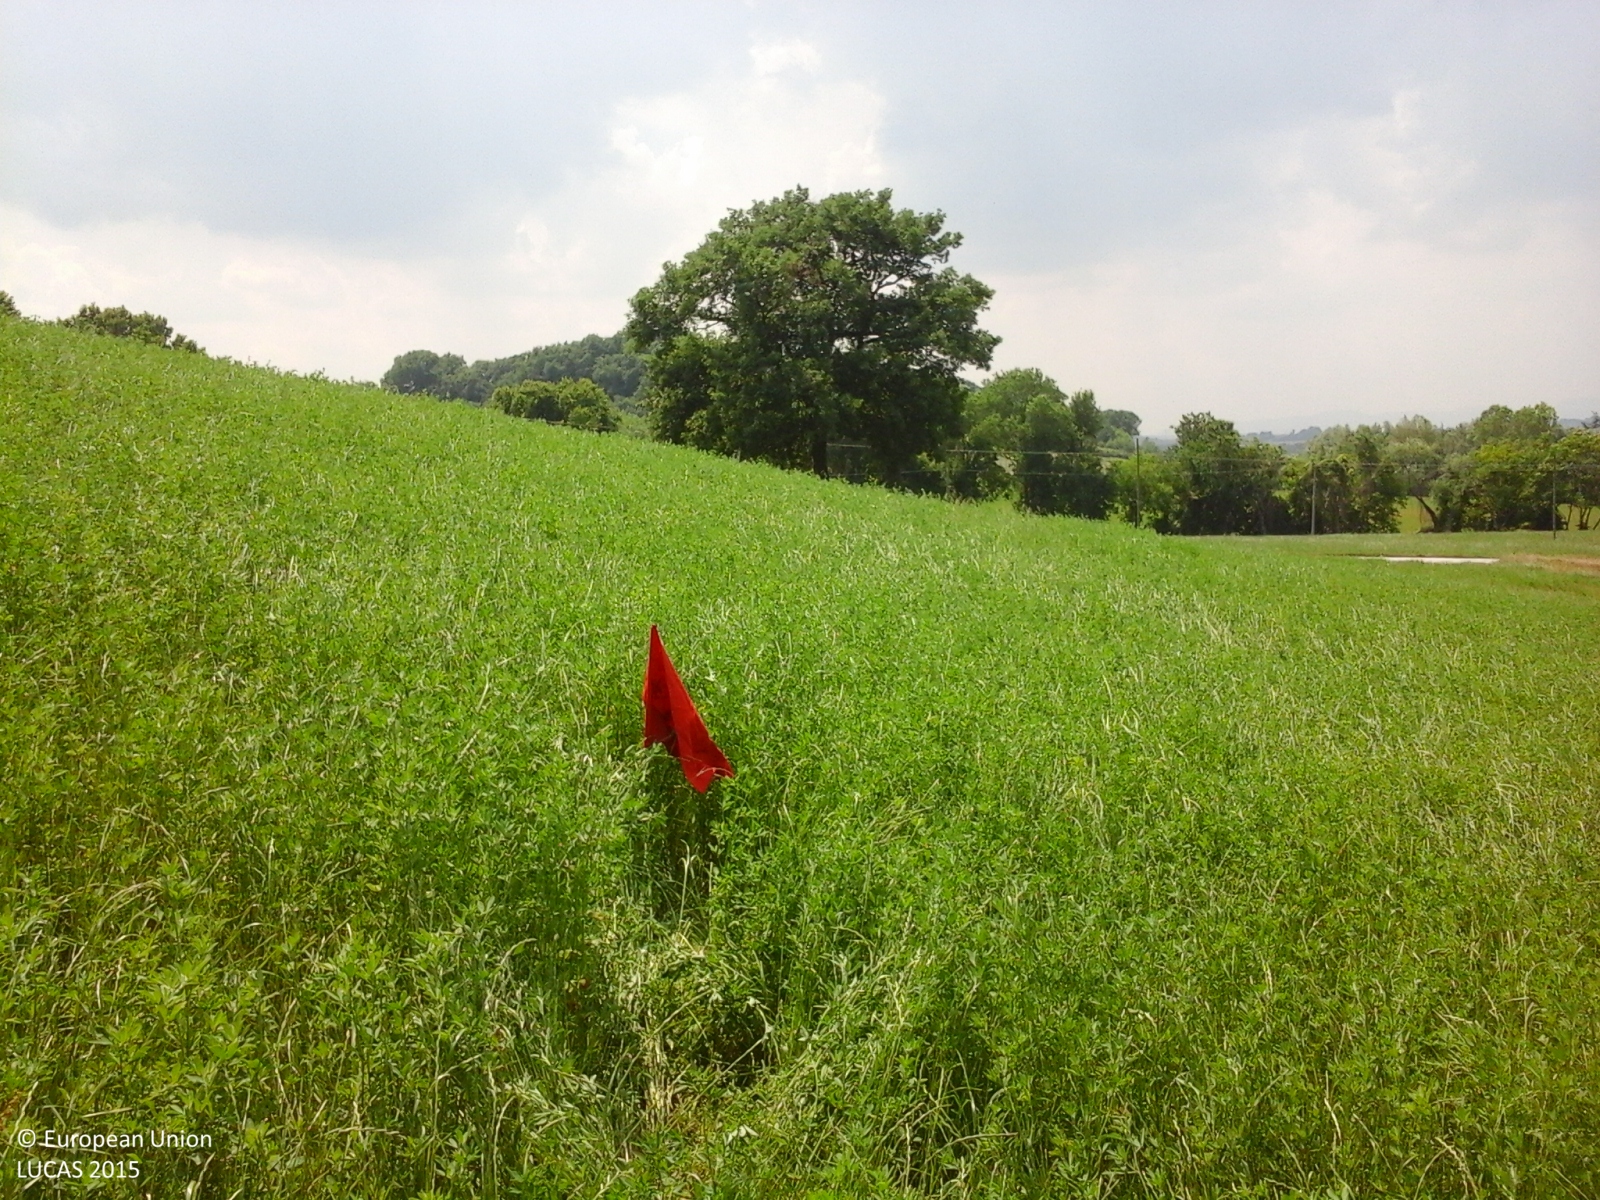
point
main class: Cropland
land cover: Lucerne
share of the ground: > 75 %
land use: Agriculture (excluding fallow land and kitchen gardens)
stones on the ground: > 50 %
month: June
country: IT
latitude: 43.2277
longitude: 13.4507
